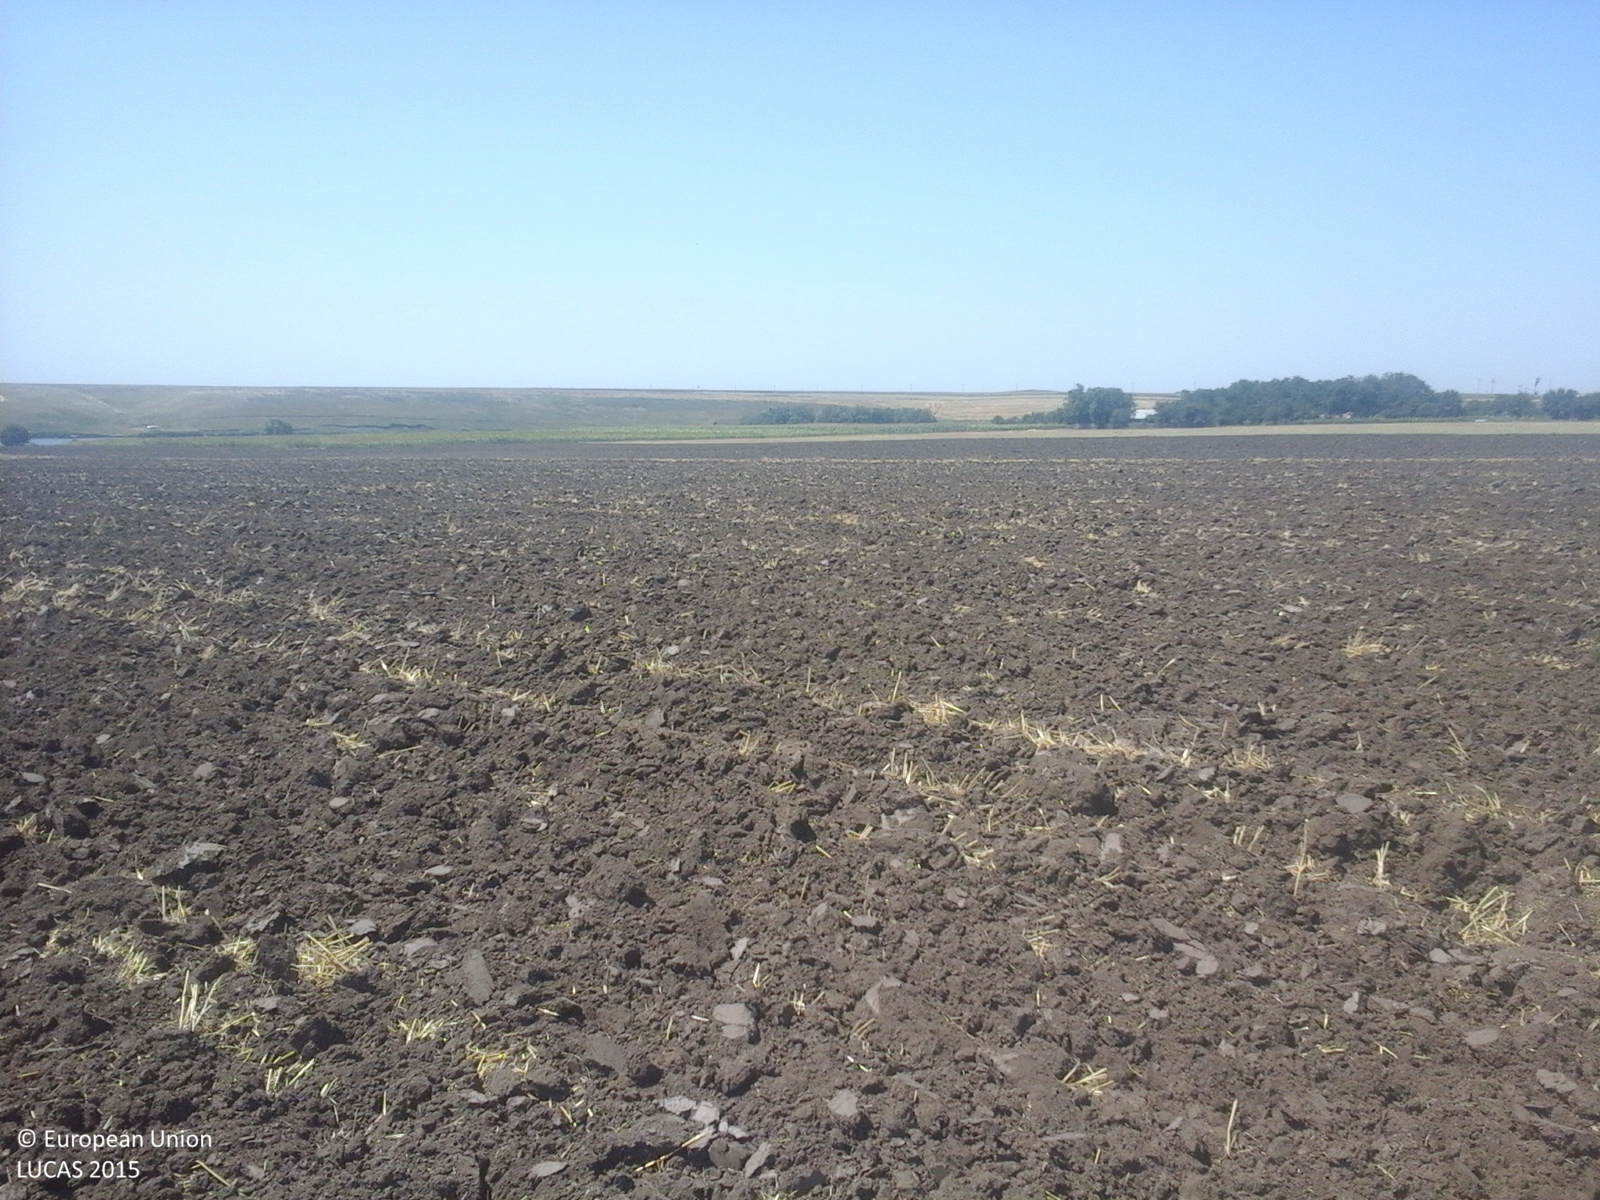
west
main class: Cropland
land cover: Durum wheat
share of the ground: < 10 %
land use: Agriculture (excluding fallow land and kitchen gardens)
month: July
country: RO
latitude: 44.4395
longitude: 26.6919
